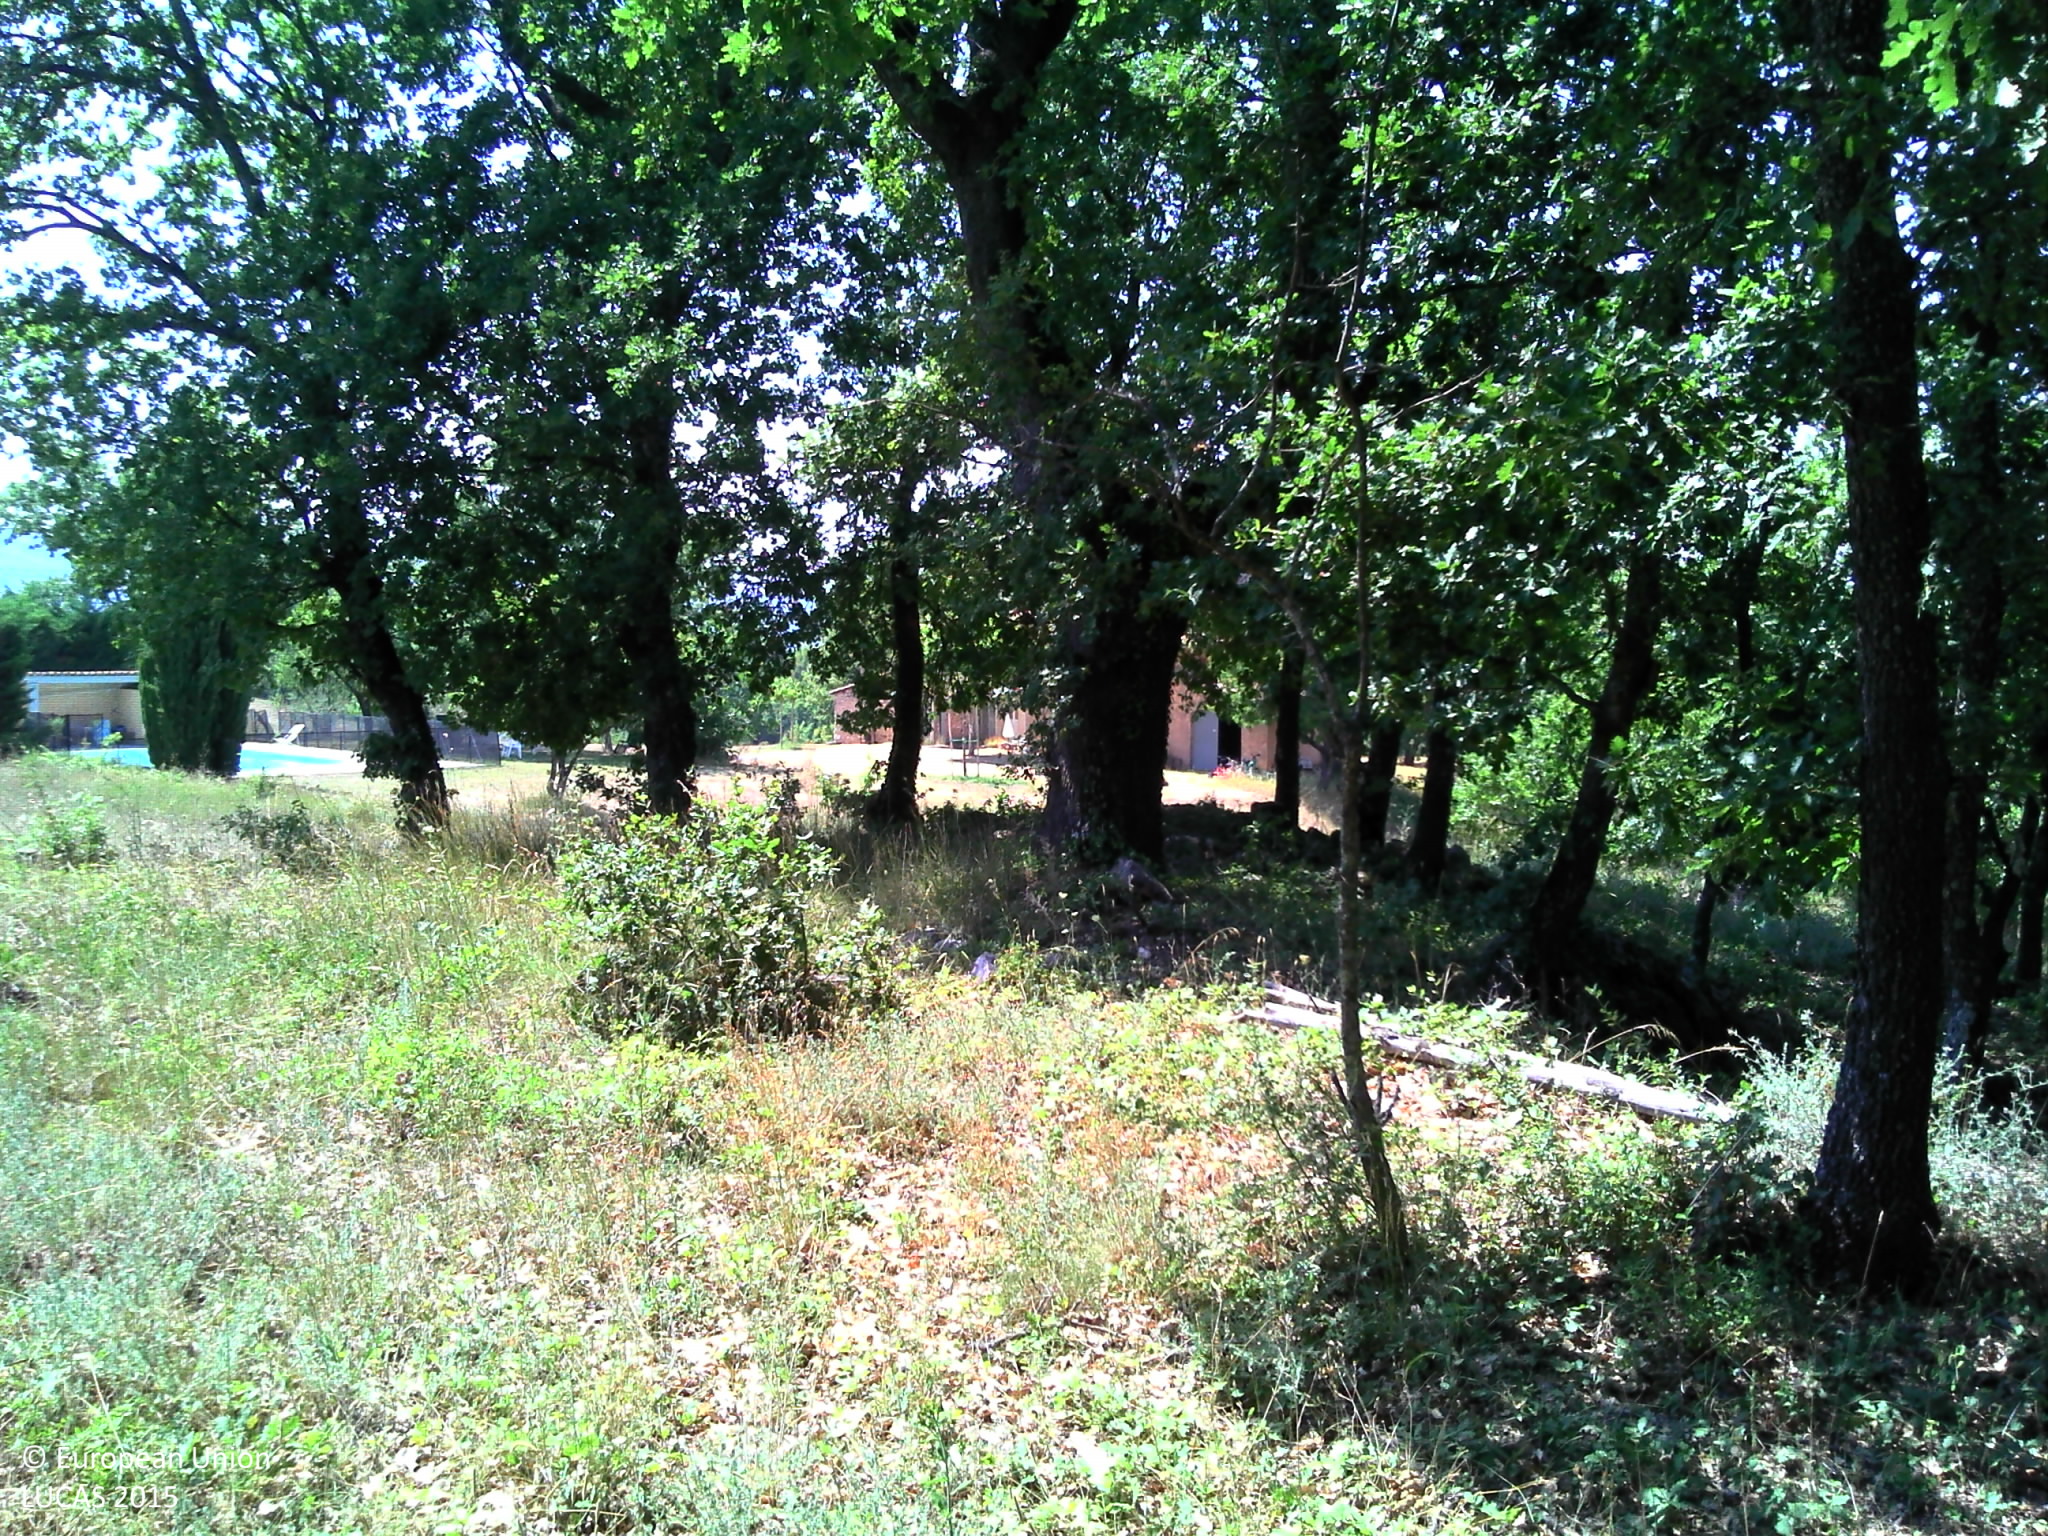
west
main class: Woodland
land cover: Broadleaved woodland
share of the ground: > 75 %
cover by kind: broadleaved forest trees 60 %, herbaceous plants 30 %, coniferous forest trees 5 %, shrubs 5 %
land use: Residential
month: August
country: FR
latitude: 43.8475
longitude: 5.3193
